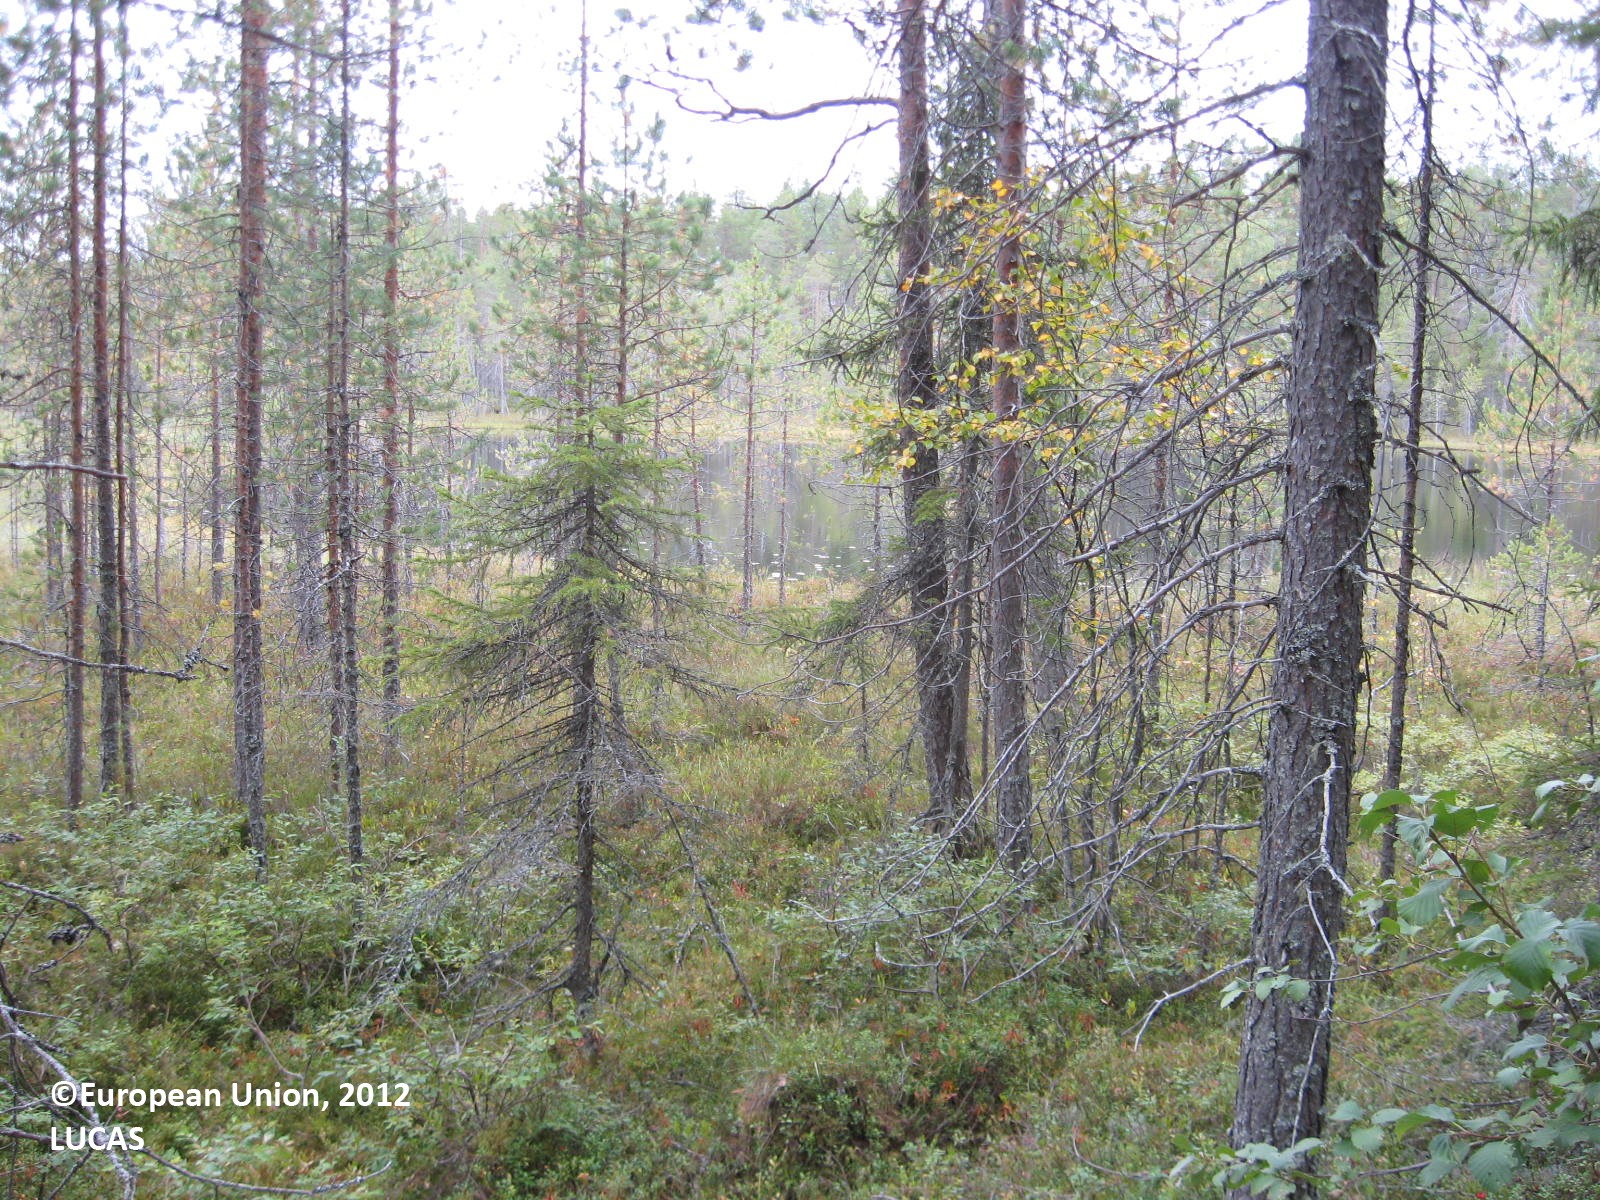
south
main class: Woodland
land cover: Pine dominated coniferous woodland
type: boreal forest
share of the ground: > 75 %
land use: Forestry
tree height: > 5 m
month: August
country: FI
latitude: 63.9534
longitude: 29.5108
